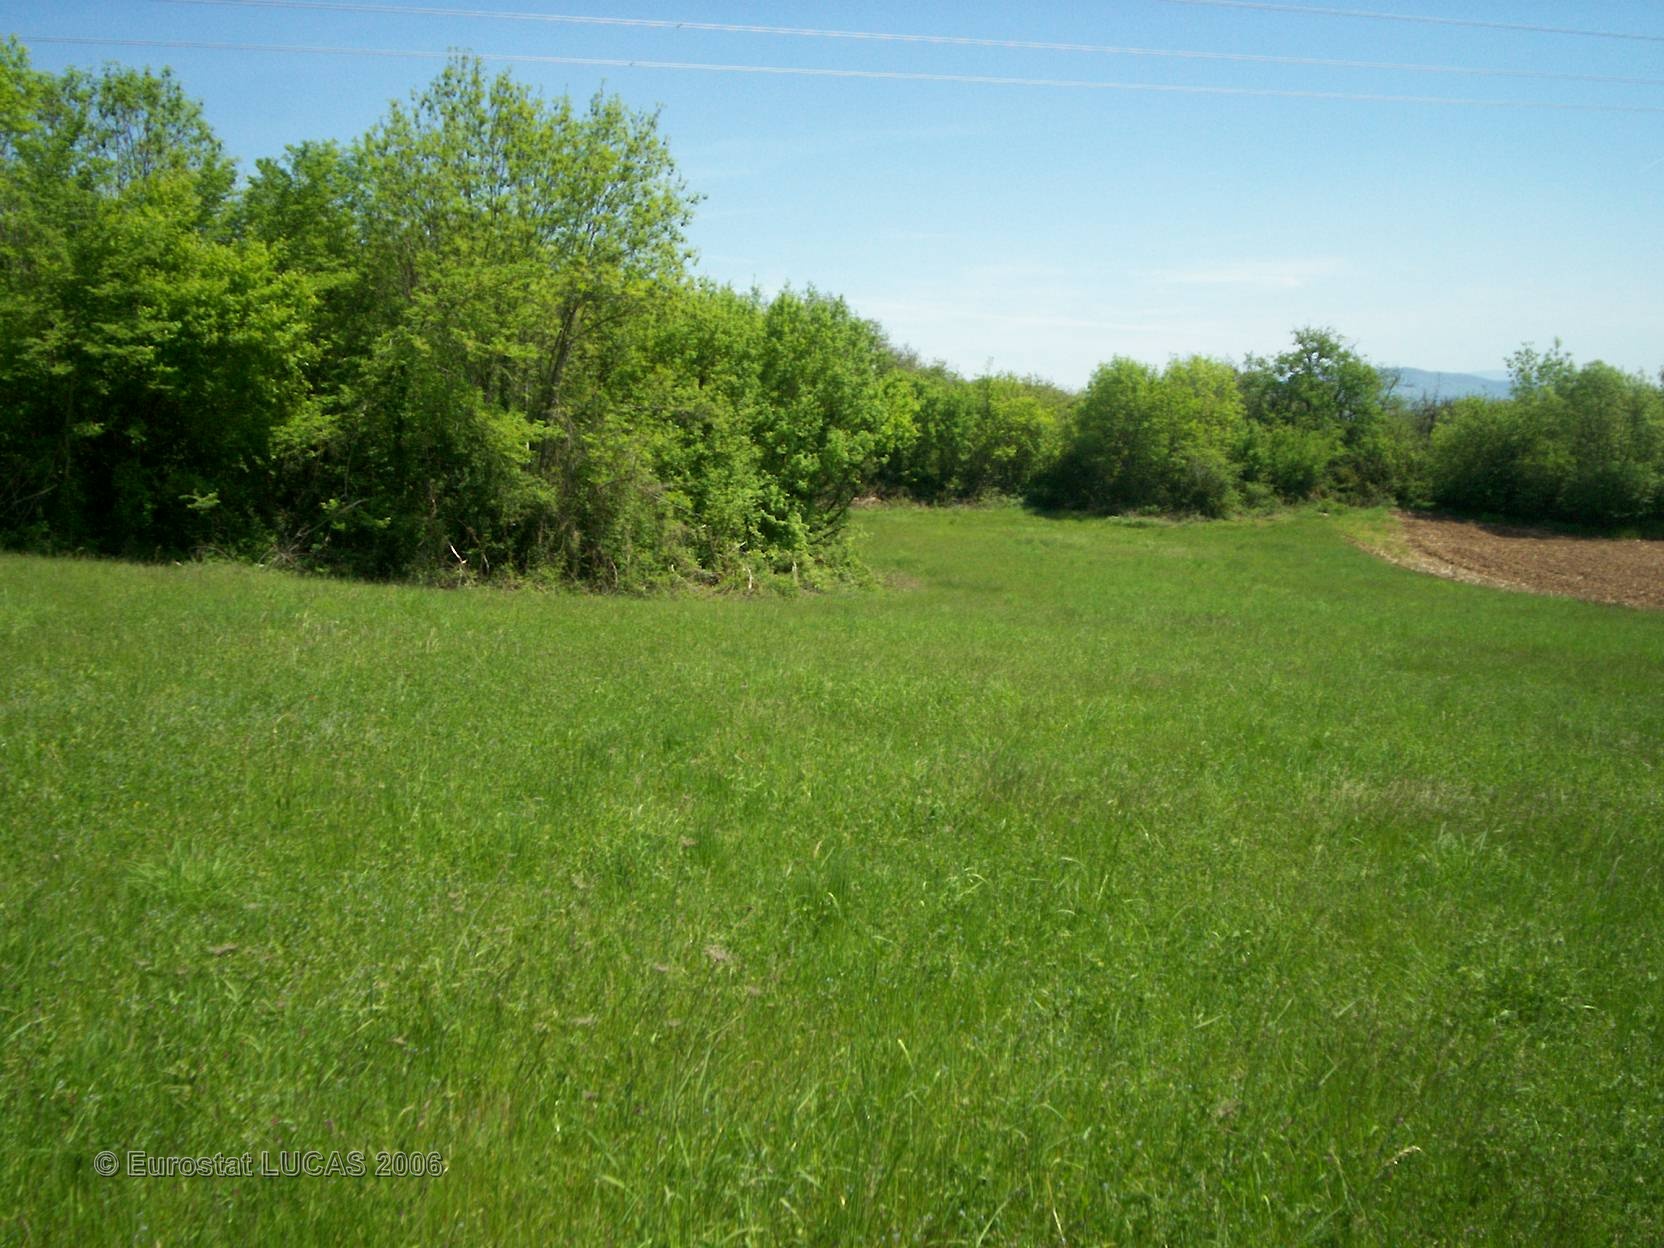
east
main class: Grassland
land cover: Grassland without tree/shrub cover
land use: Agriculture (excluding fallow land and kitchen gardens)
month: May
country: FR
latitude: 45.7320
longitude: 5.4679
